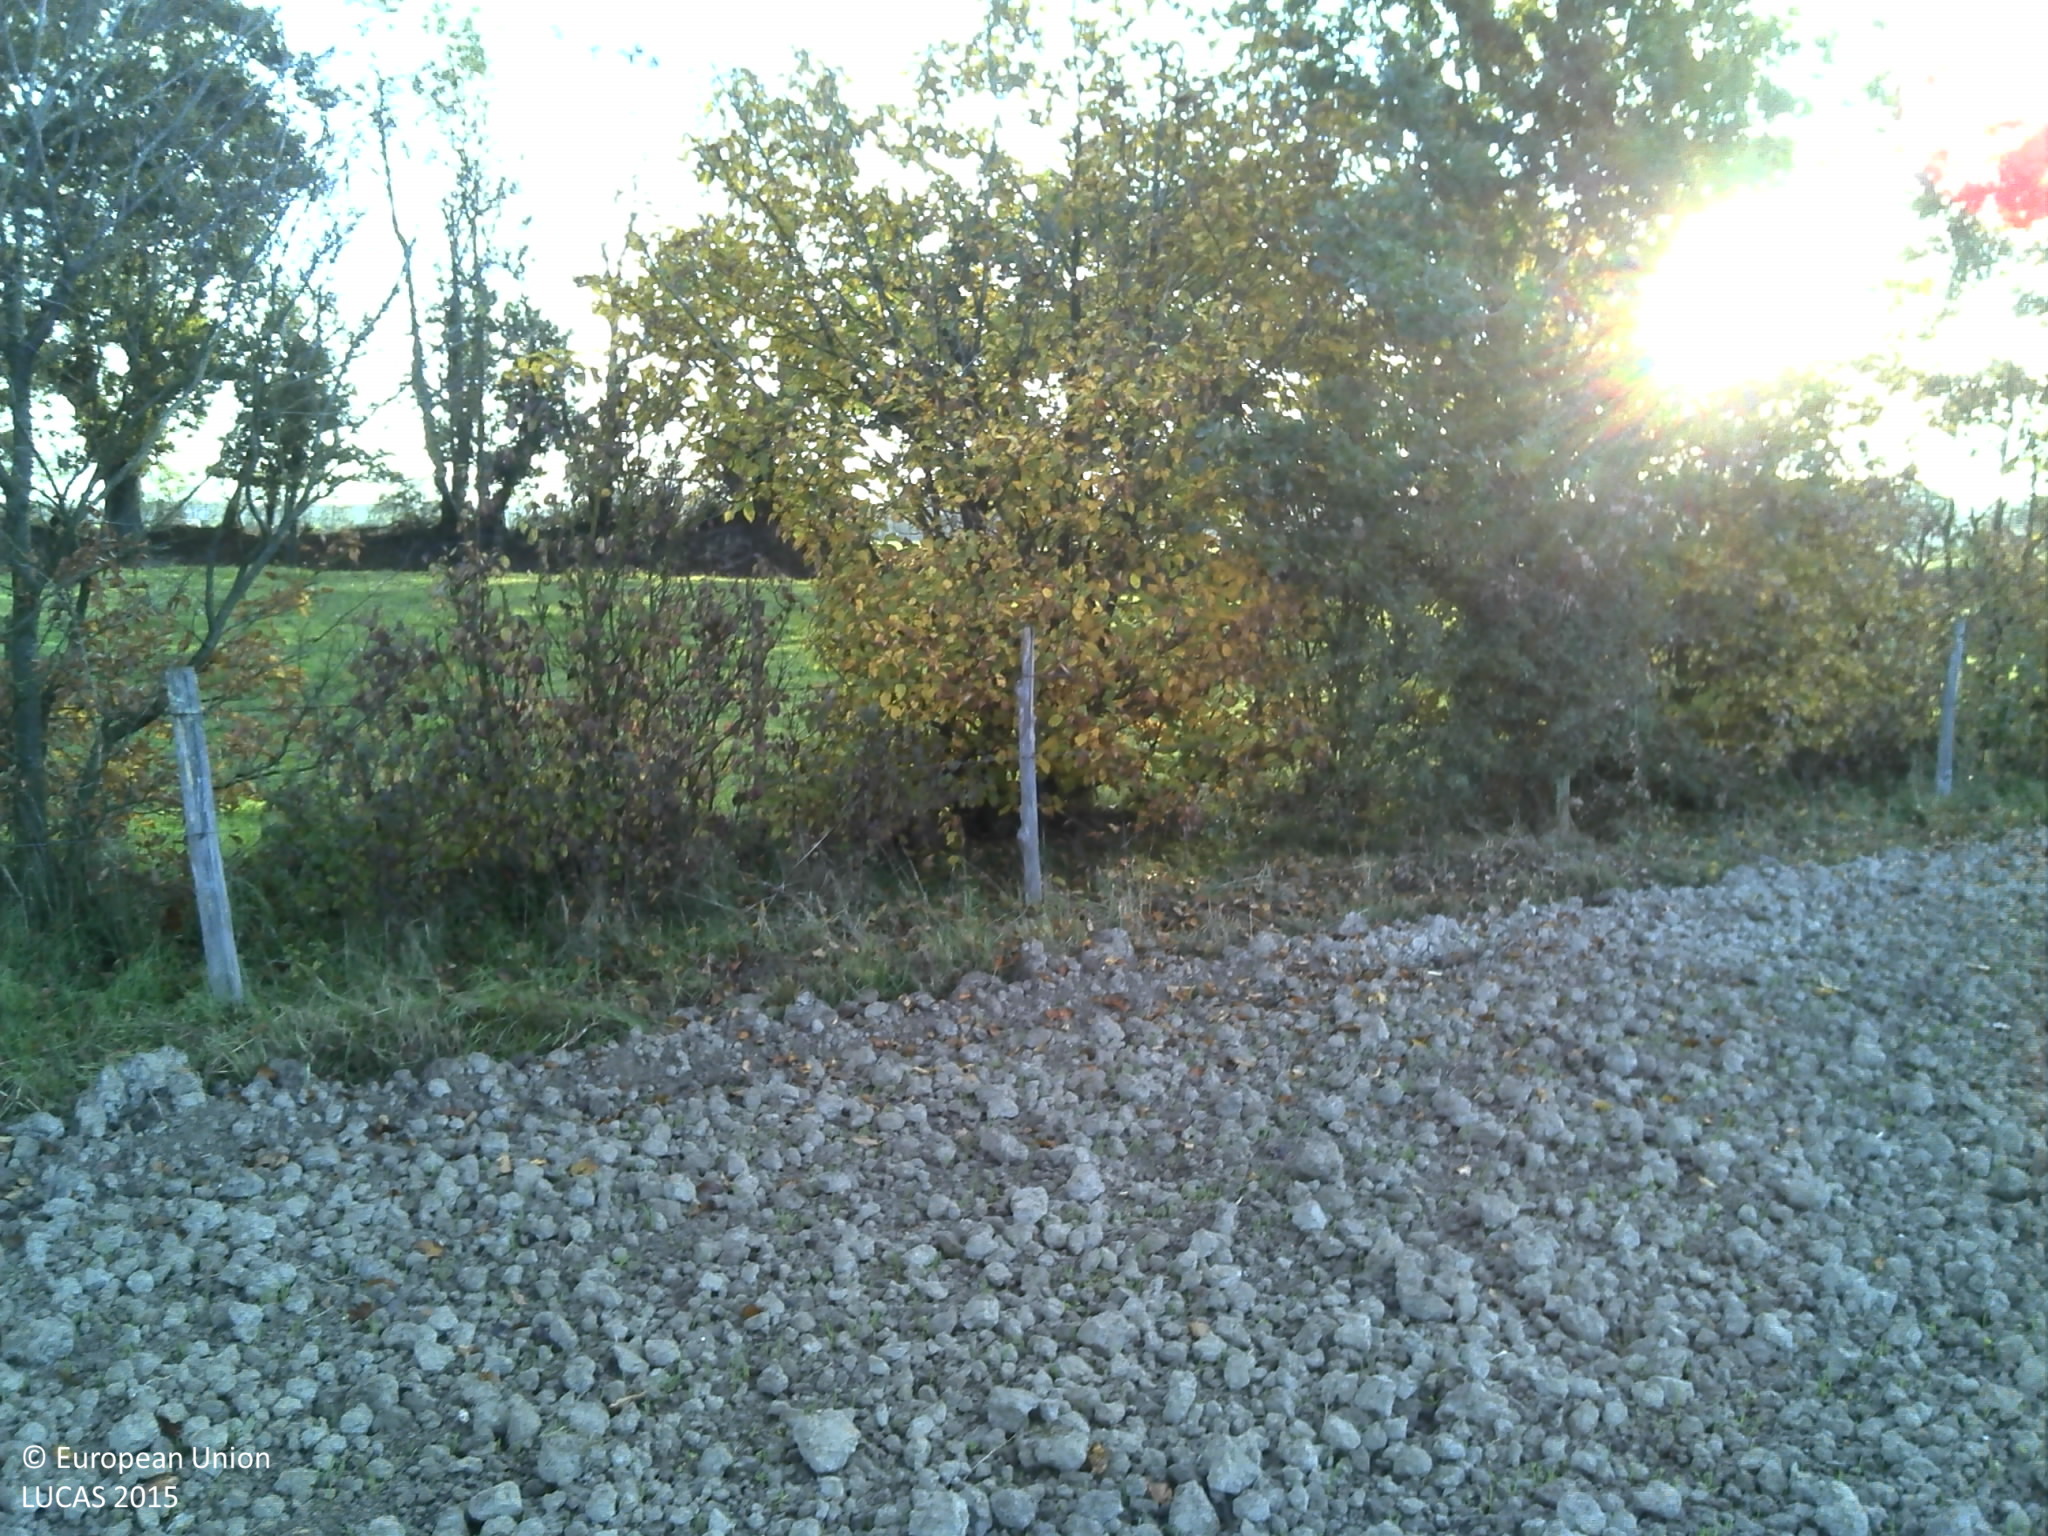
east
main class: Cropland
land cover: Common wheat
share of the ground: < 10 %
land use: Agriculture (excluding fallow land and kitchen gardens)
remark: Tilled/Sowed
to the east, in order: Common wheat; Fences; Abandoned hedges; Fences; Grassland without tree/shrub cover; Broadleaved woodland; Fences; Grassland without tree/shrub cover; Fences; Grassland without tree/shrub cover
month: November
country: FR
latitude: 47.5772
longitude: -1.0321
